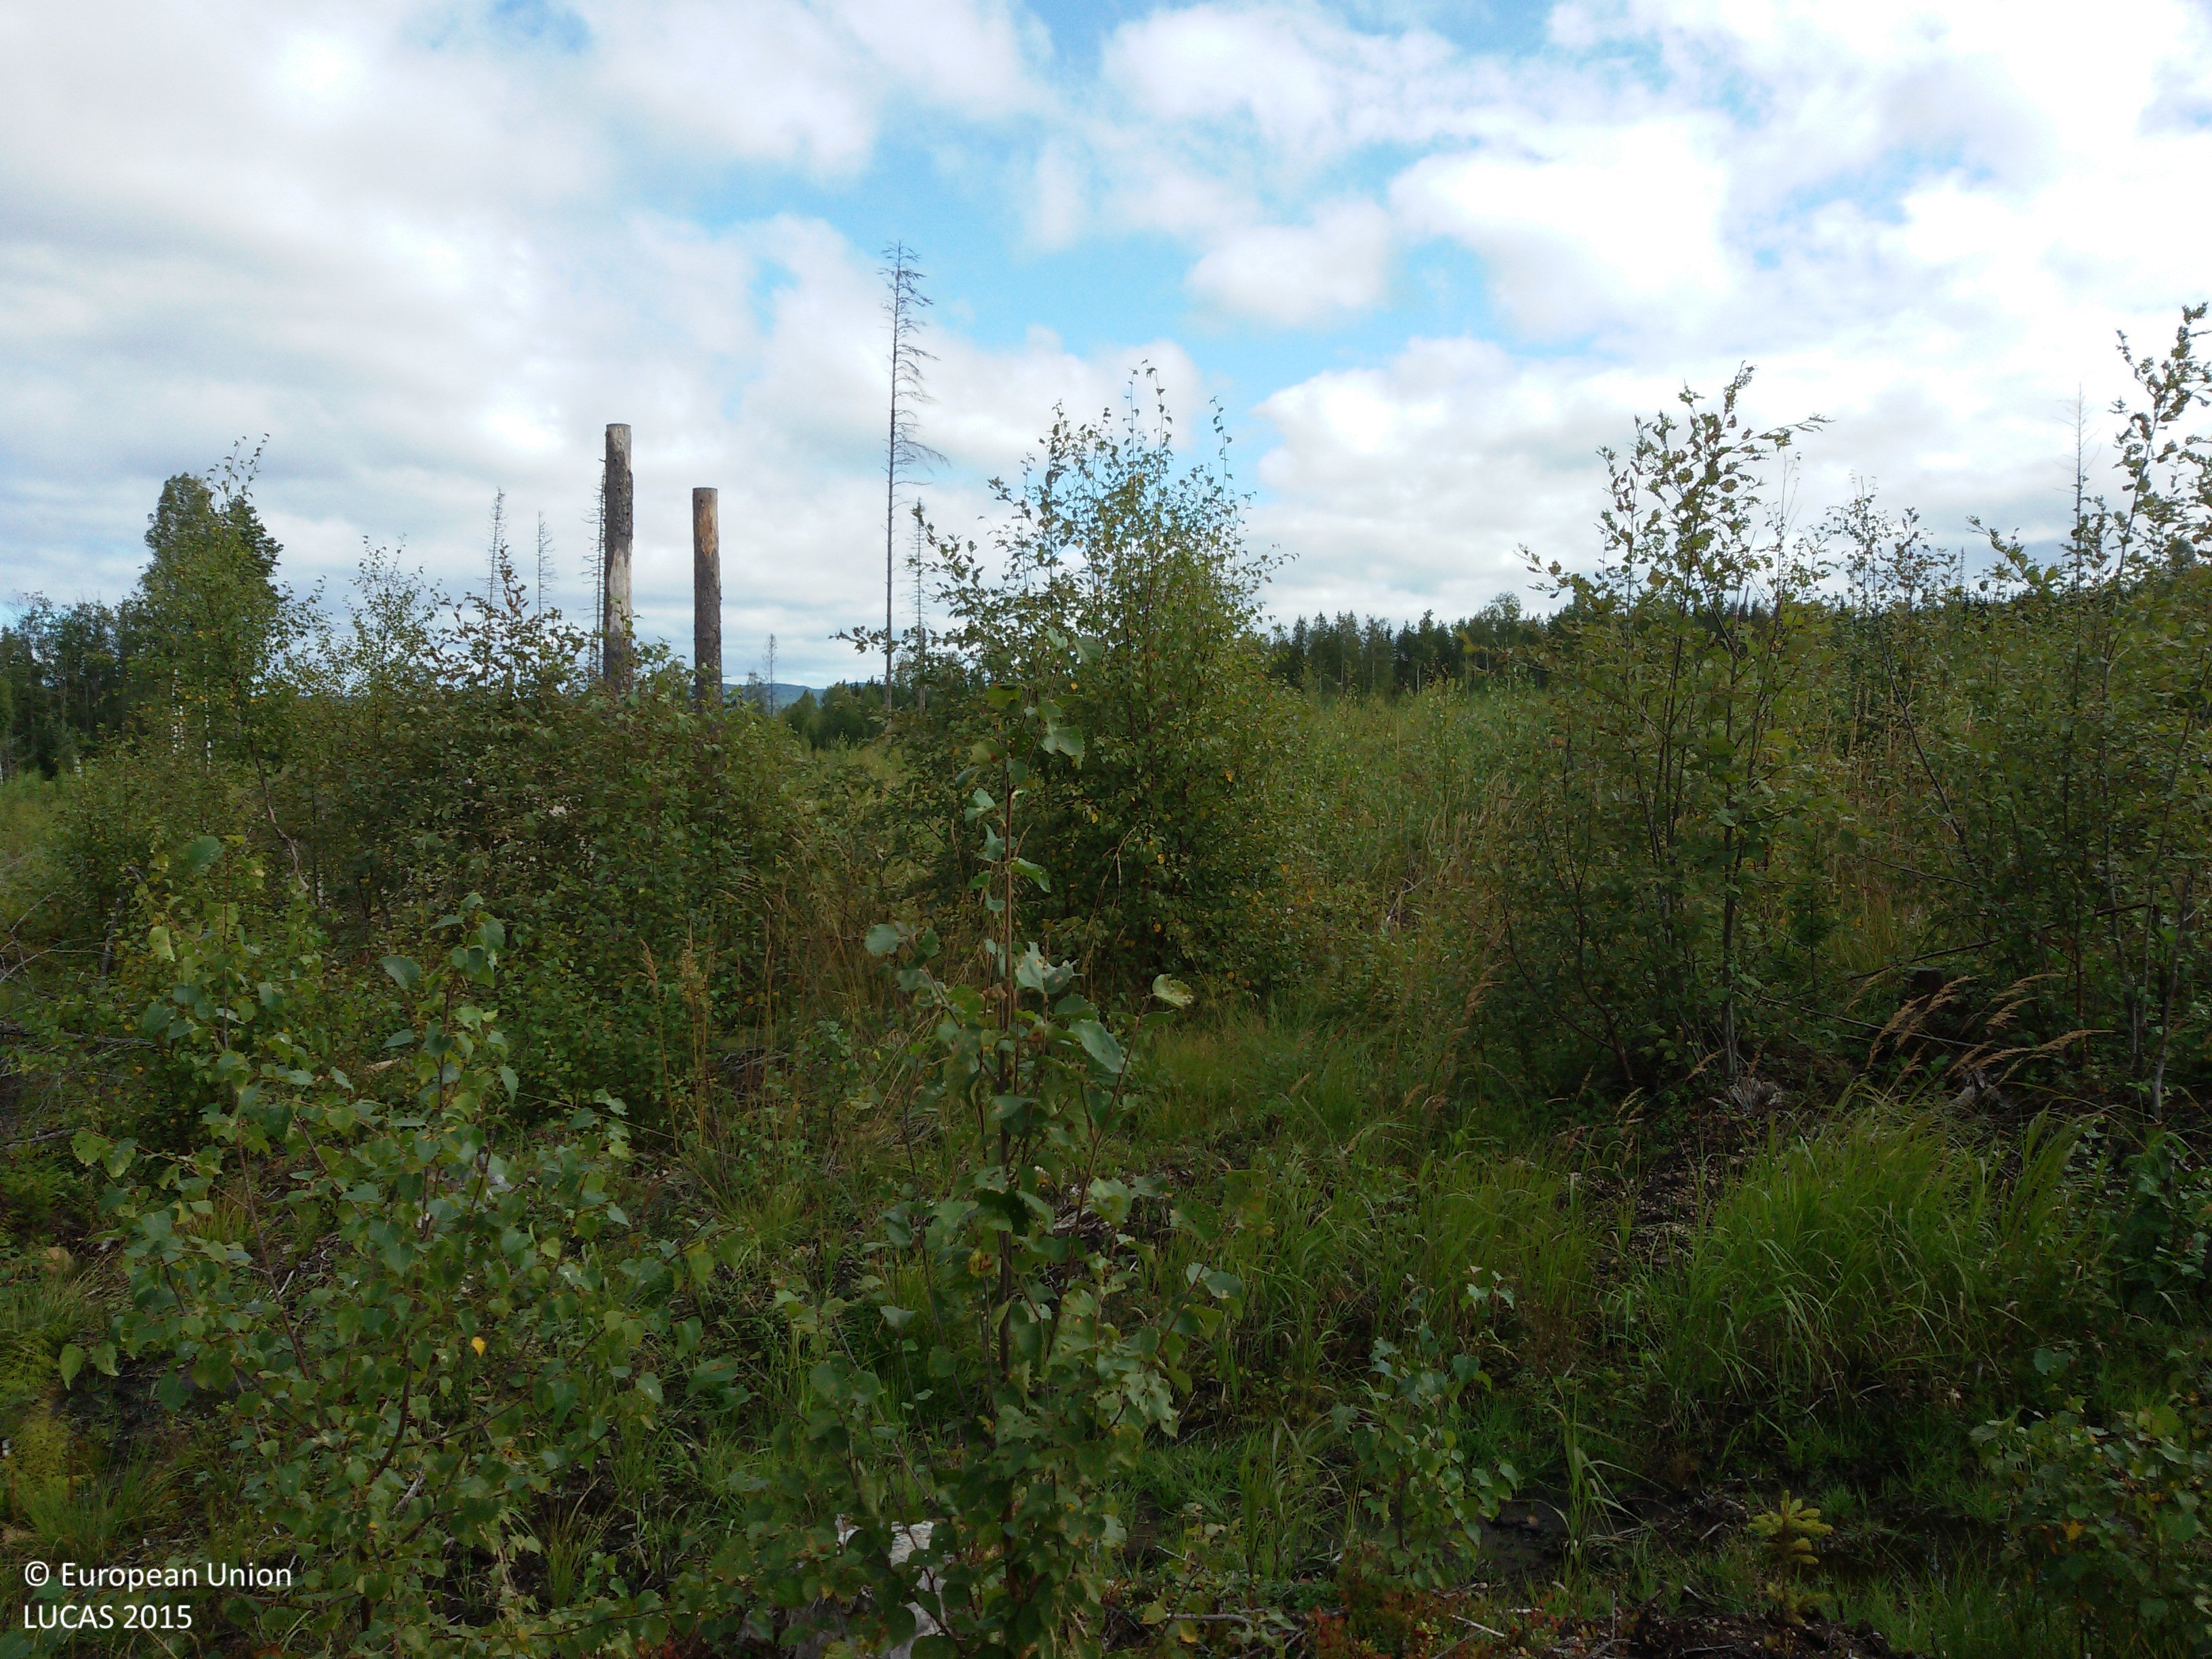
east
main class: Woodland
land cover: Broadleaved woodland
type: boreal forest
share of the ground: 50 - 75 %
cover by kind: broadleaved forest trees 50 %, herbaceous plants 35 %, lichens and mosses 10 %, coniferous forest trees 5 %
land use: Forestry
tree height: < 5 m
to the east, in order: Broadleaved woodland; Rivers and streams; Broadleaved woodland
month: September
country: SE
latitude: 60.9799
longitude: 15.4004
